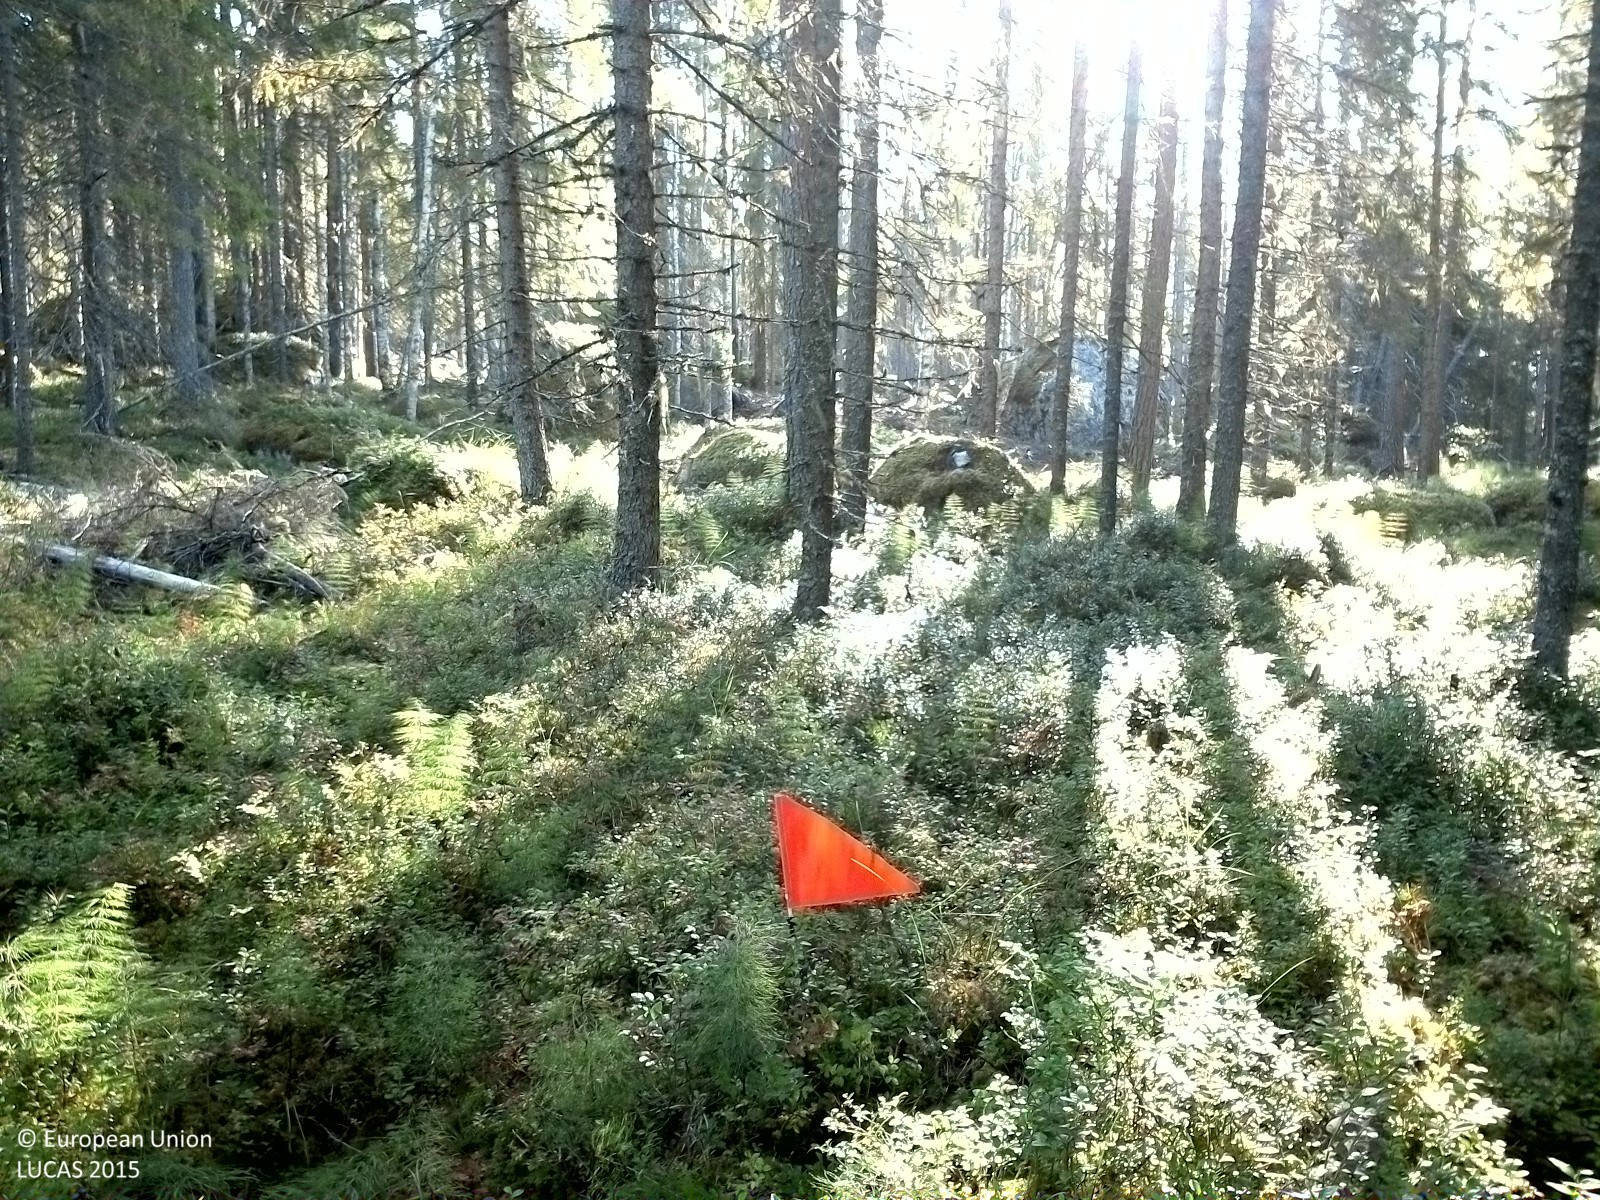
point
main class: Woodland
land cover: Spruce dominated coniferous woodland
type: boreal forest
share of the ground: 50 - 75 %
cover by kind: coniferous forest trees 50 %, shrubs 30 %, herbaceous plants 15 %, broadleaved forest trees 5 %
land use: Forestry
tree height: > 5 m
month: September
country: SE
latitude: 62.5609
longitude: 16.1064
